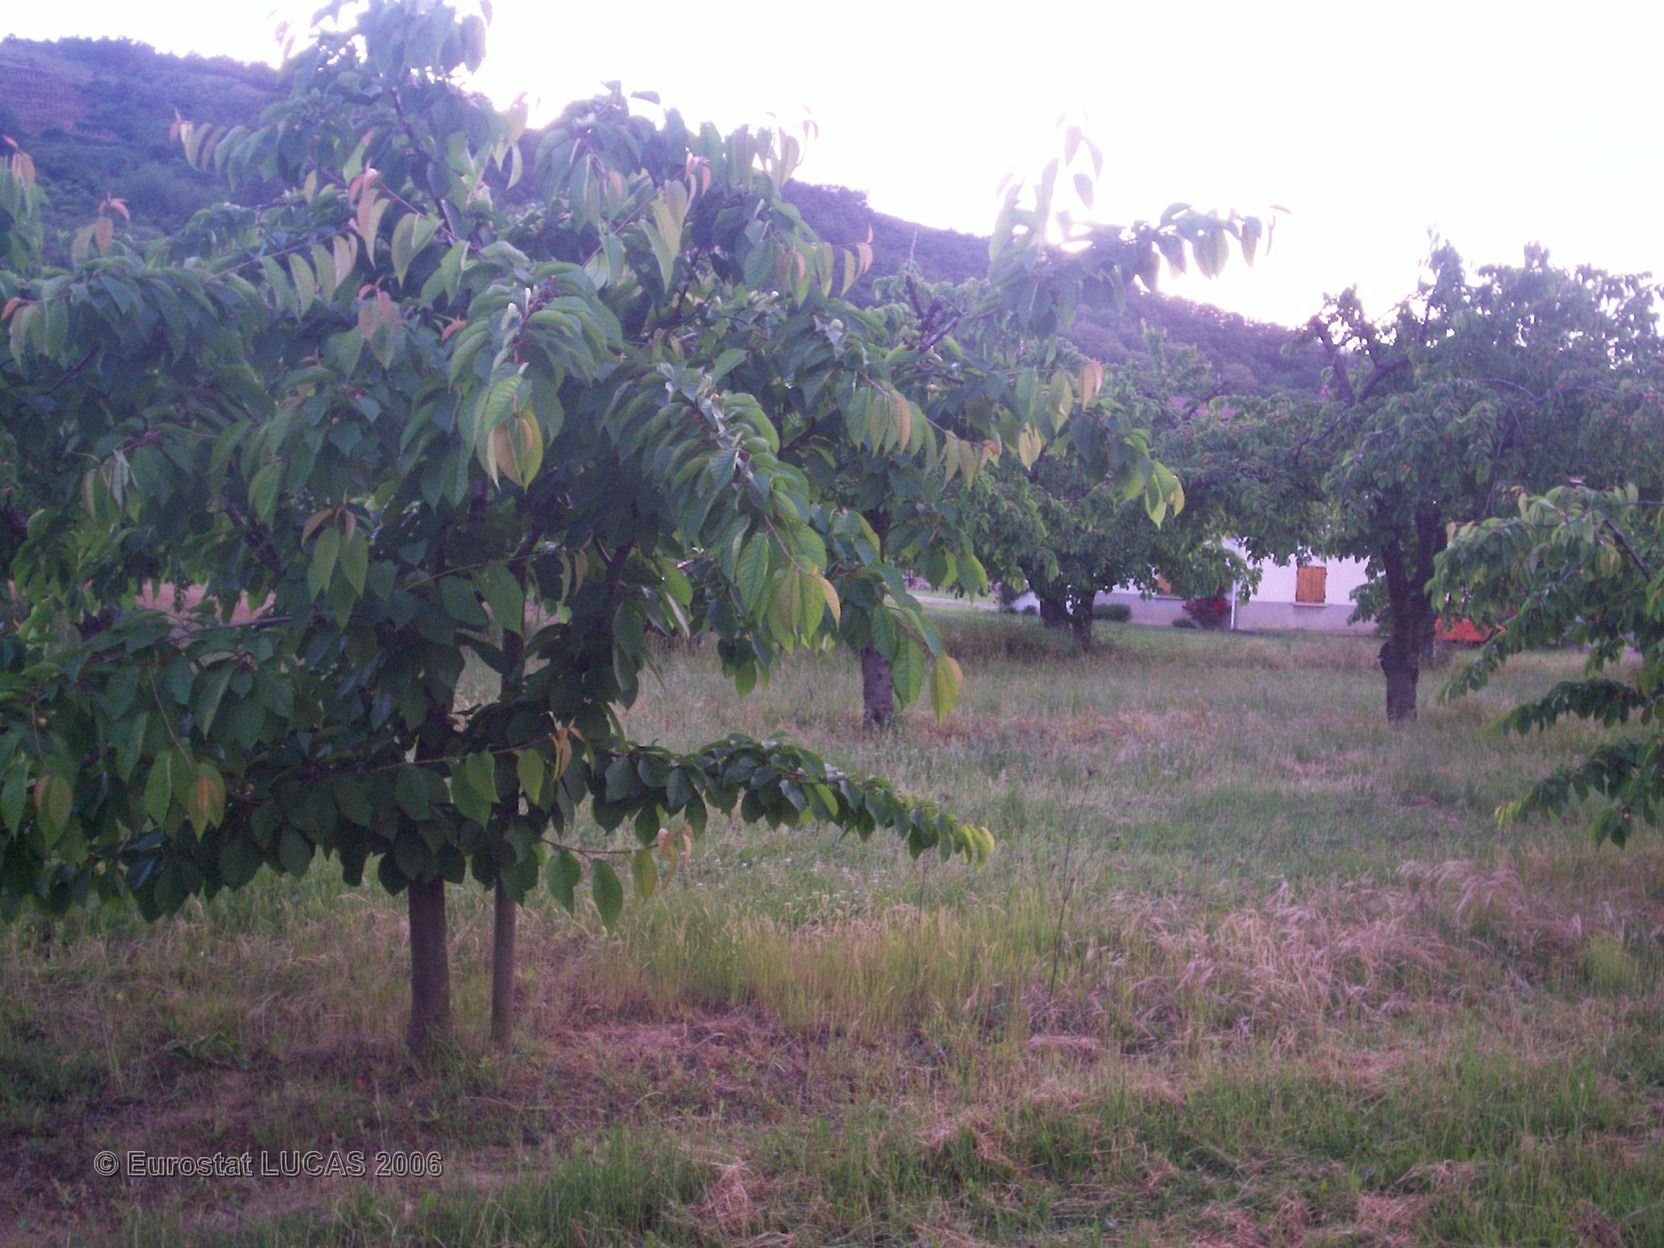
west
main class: Cropland
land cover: Cherry fruit
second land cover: Grassland with sparse tree/shrub cover
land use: Agriculture (excluding fallow land and kitchen gardens)
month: May
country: FR
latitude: 45.3561
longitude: 4.7580
